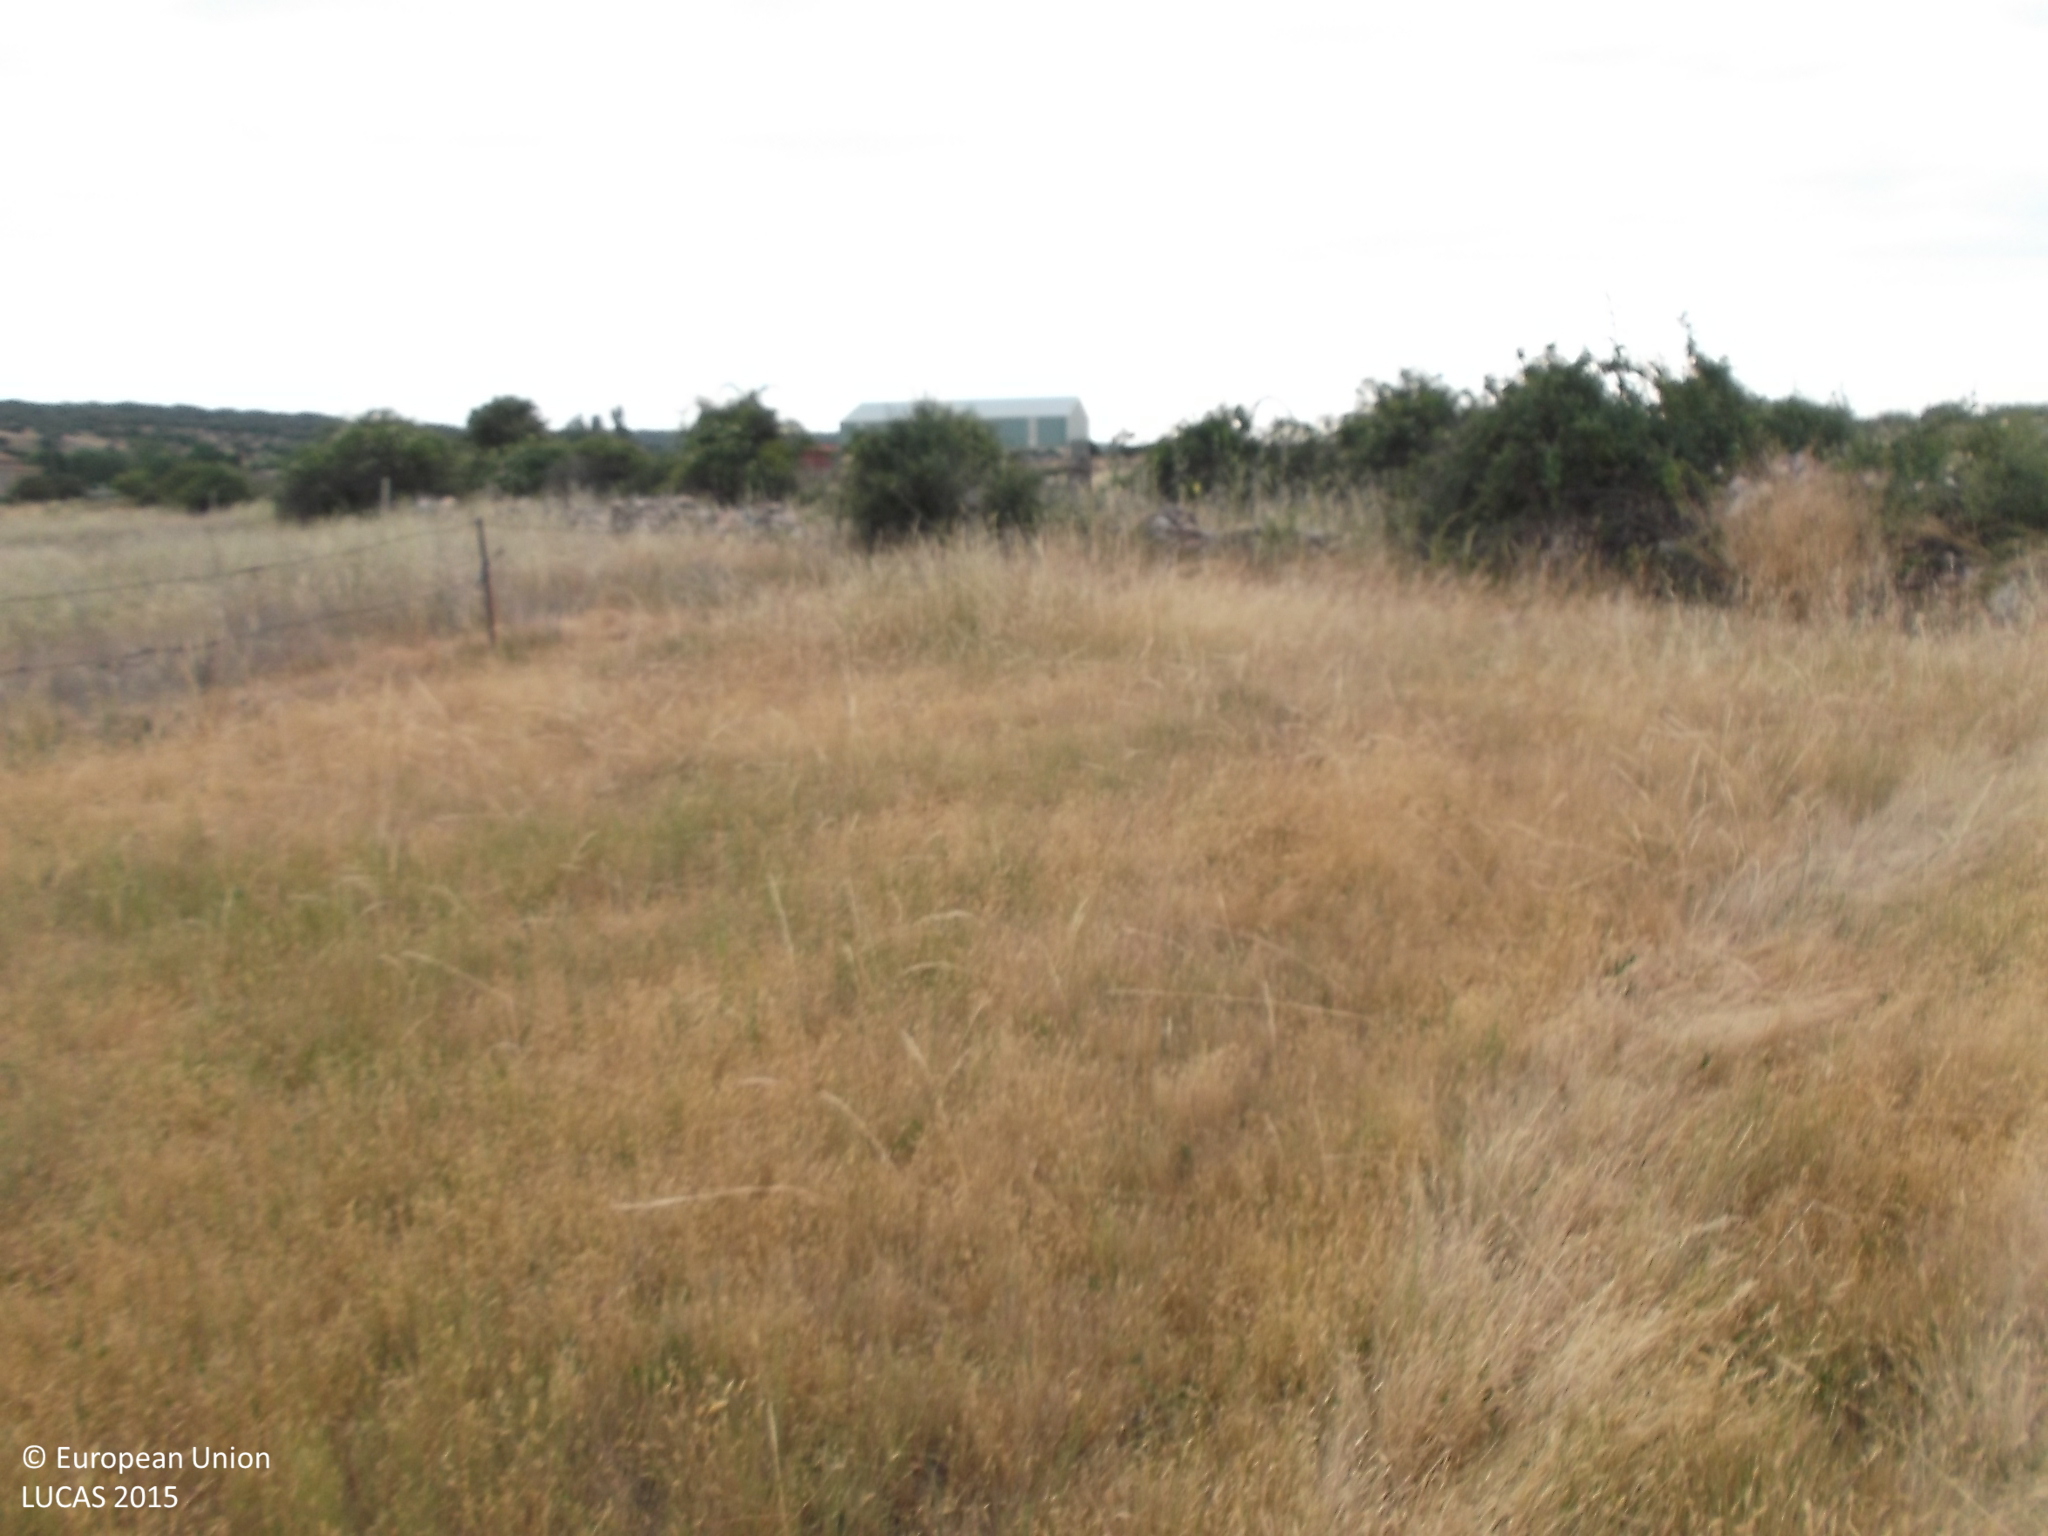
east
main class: Grassland
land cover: Grassland without tree/shrub cover
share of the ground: > 75 %
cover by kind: herbaceous plants 100 %
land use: Agriculture (excluding fallow land and kitchen gardens)
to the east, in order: Grassland without tree/shrub cover; Fences; Dry stone walls; Grass margins; Tracks; Shruby margins; Dry stone walls; Fences; Grassland without tree/shrub cover; Fences; Dry stone walls; Grassland without tree/shrub cover; Dry stone walls; Fences; Grassland without tree/shrub cover; Fences; Dry stone walls; Grassland without tree/shrub cover; Dry stone walls; Other bare soil; Artificial constructions in urban areas; Other bare soil; Dry stone walls; Grass margins; Tracks; Grass margins; Shruby margins; Dry stone walls; Grassland without tree/shrub cover
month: June
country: ES
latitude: 40.7978
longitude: -6.3624
